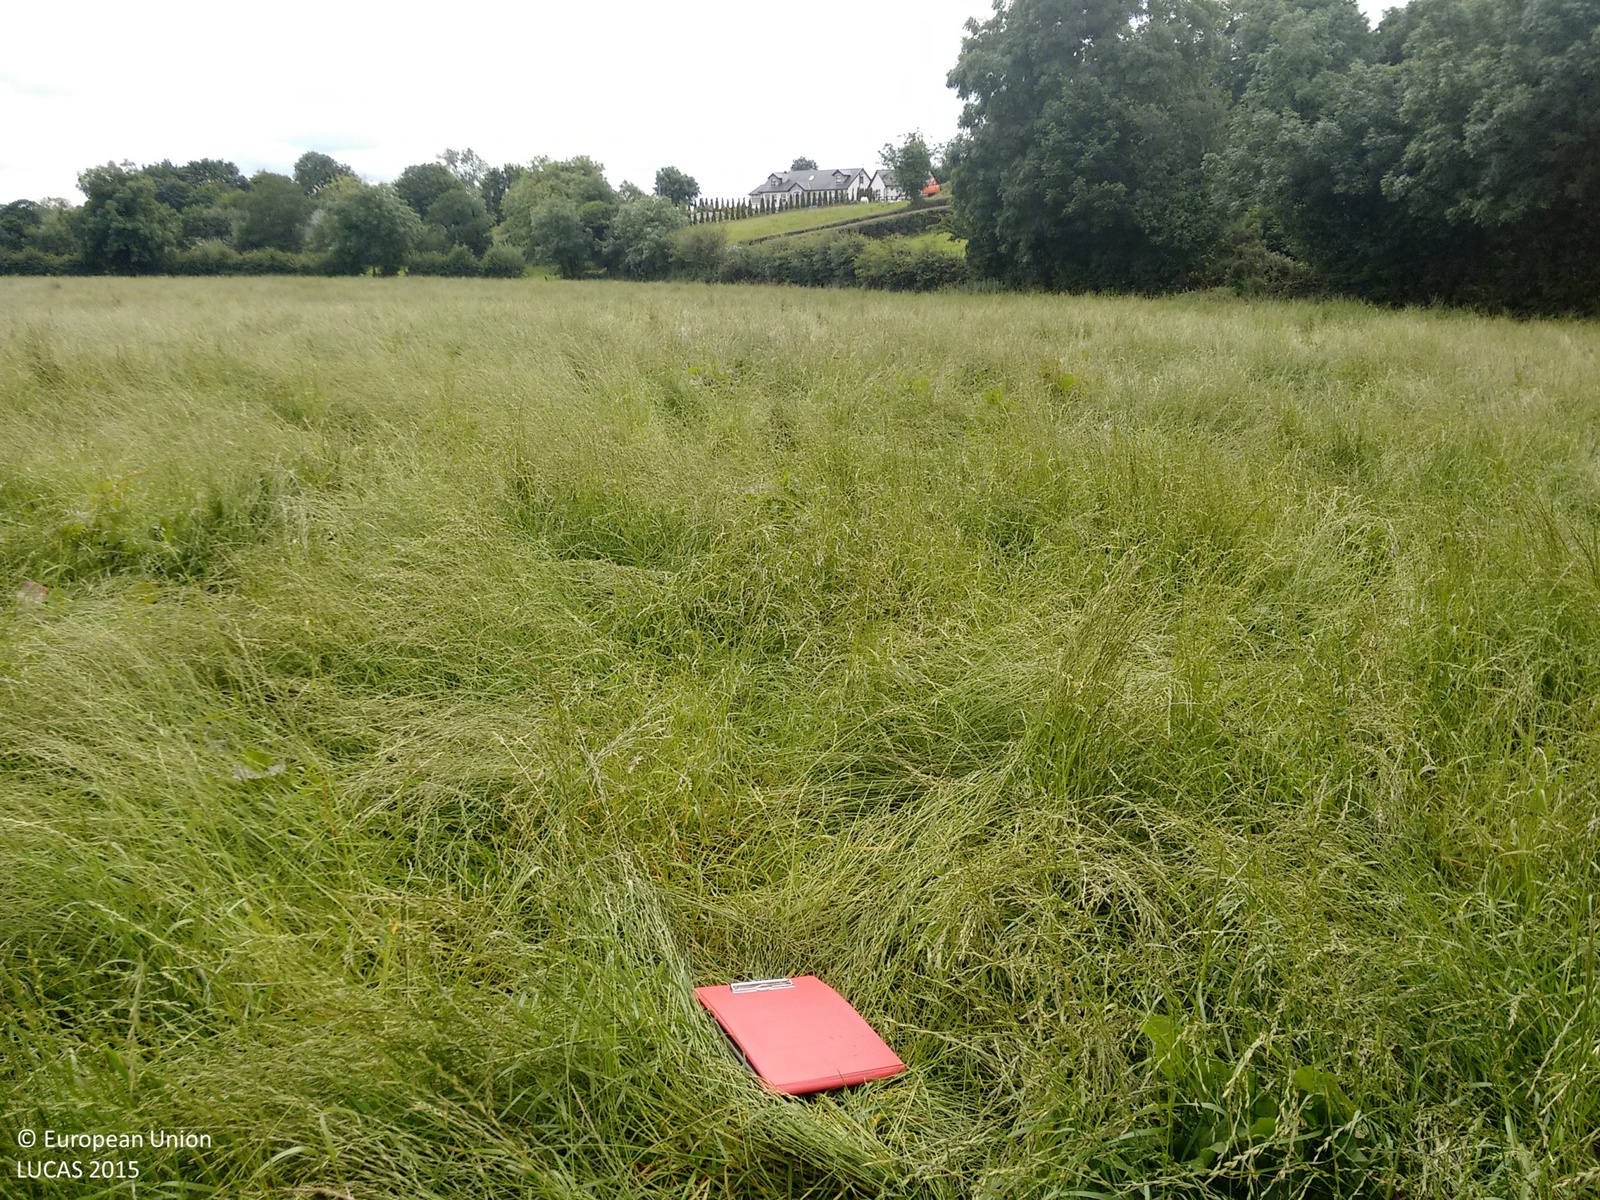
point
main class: Grassland
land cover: Grassland without tree/shrub cover
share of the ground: > 75 %
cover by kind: herbaceous plants 100 %
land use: Agriculture (excluding fallow land and kitchen gardens)
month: August
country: GB
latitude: 54.0585
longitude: -6.6443
